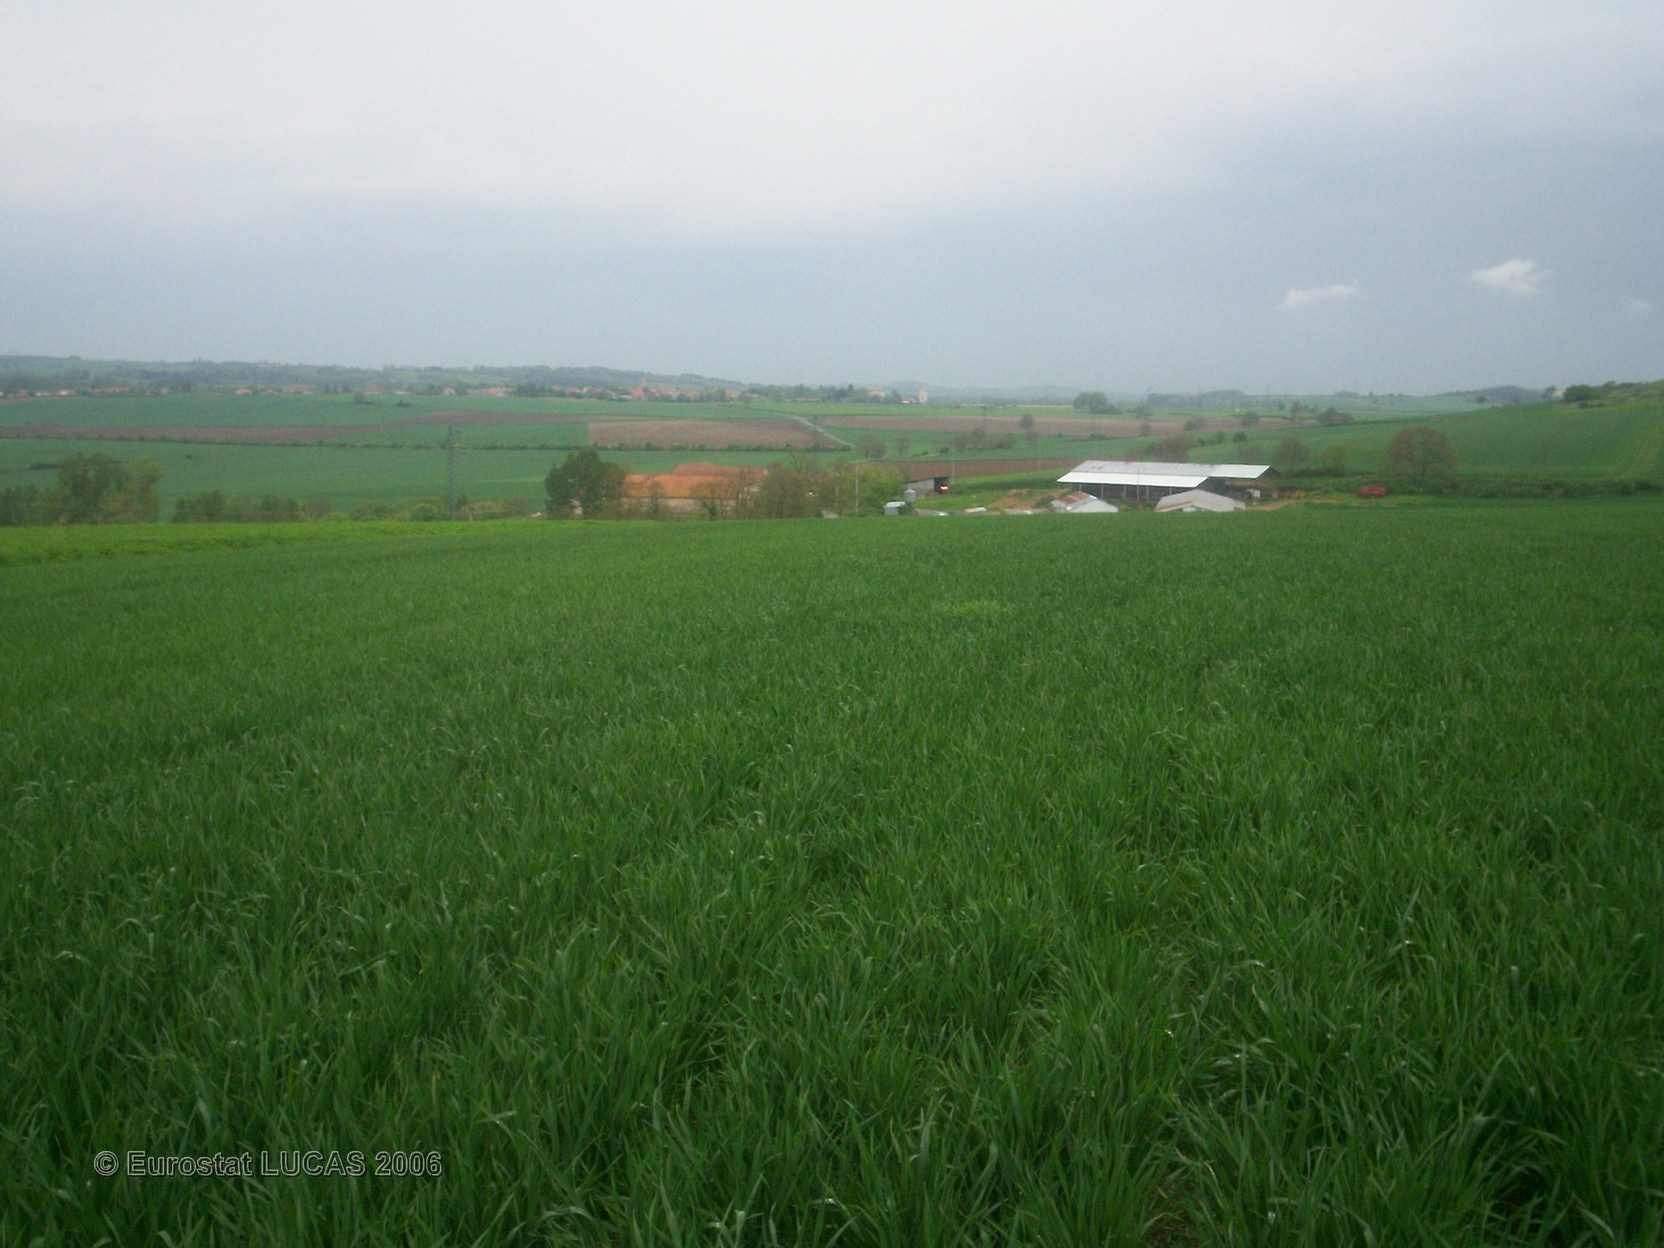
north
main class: Cropland
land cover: Common wheat
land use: Agriculture (excluding fallow land and kitchen gardens)
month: May
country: FR
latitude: 46.0224
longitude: 3.1398
